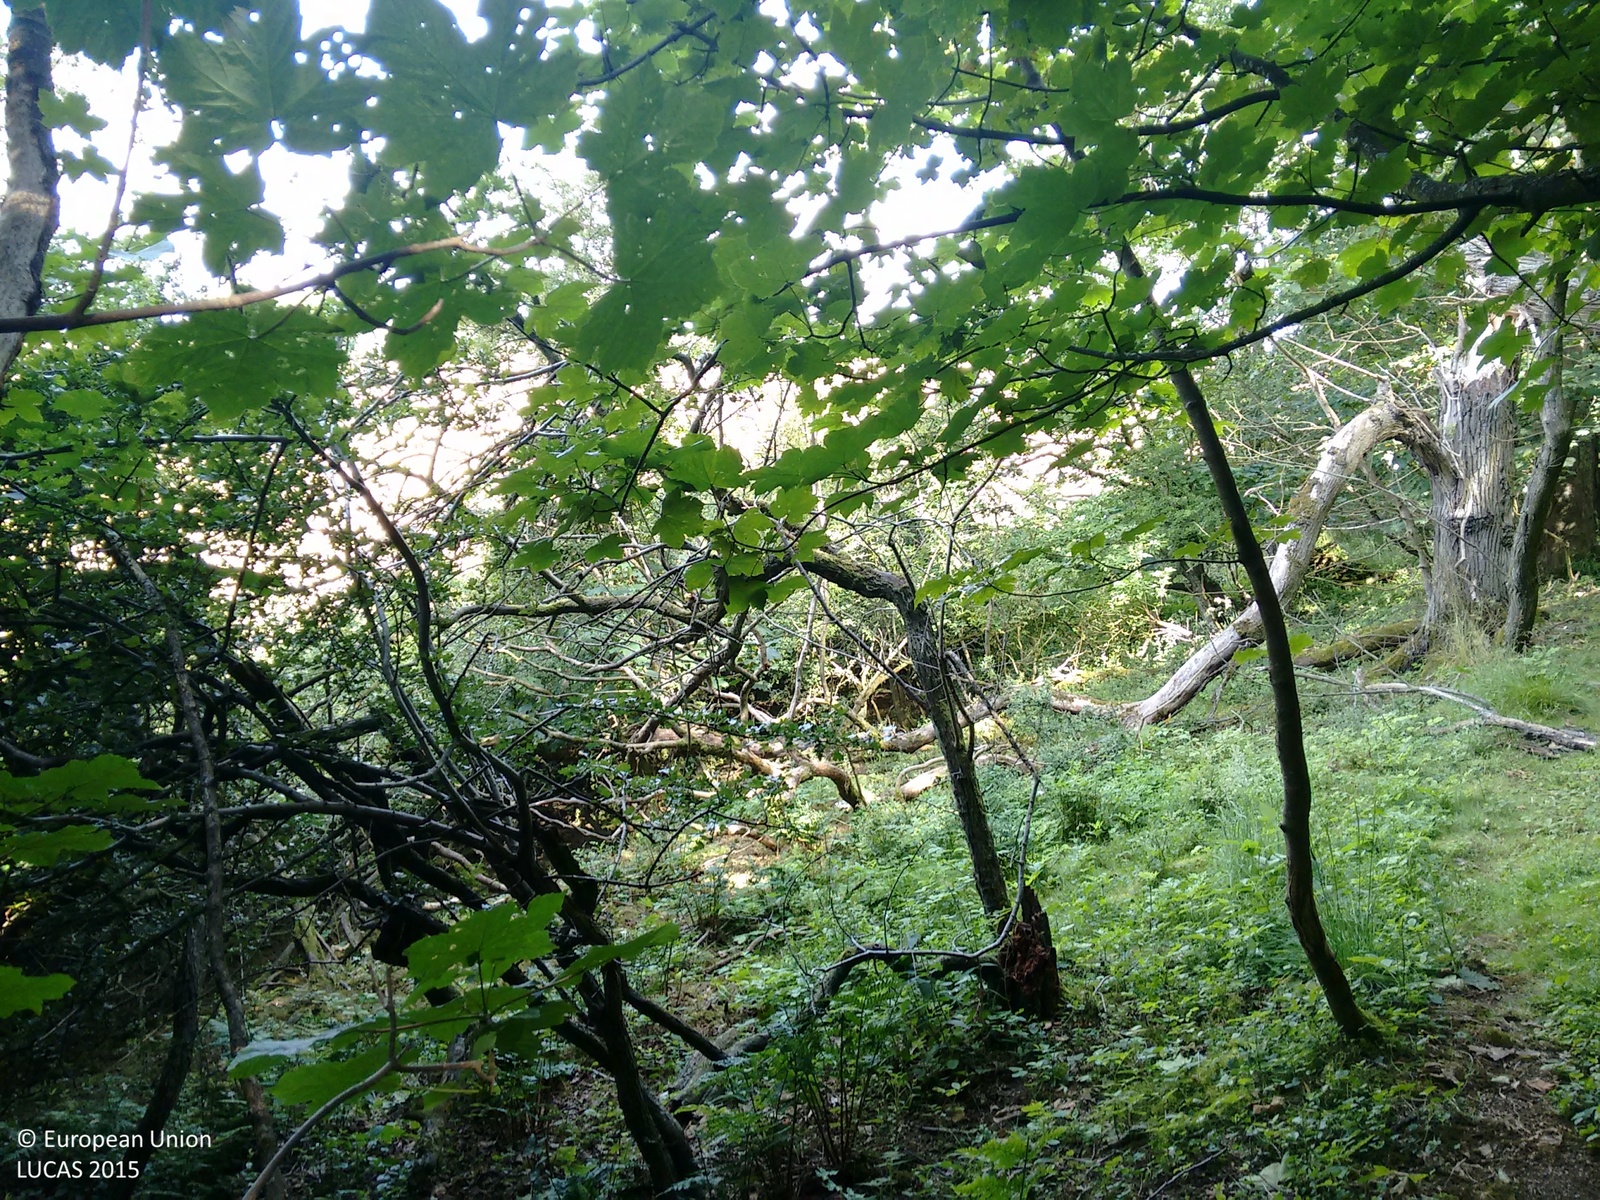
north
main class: Woodland
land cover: Broadleaved woodland
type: mesophytic deciduous forest
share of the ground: > 75 %
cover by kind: broadleaved forest trees 100 %
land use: Amenities, museums, leisure
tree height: > 5 m
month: July
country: GB
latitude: 56.0307
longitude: -3.3780
